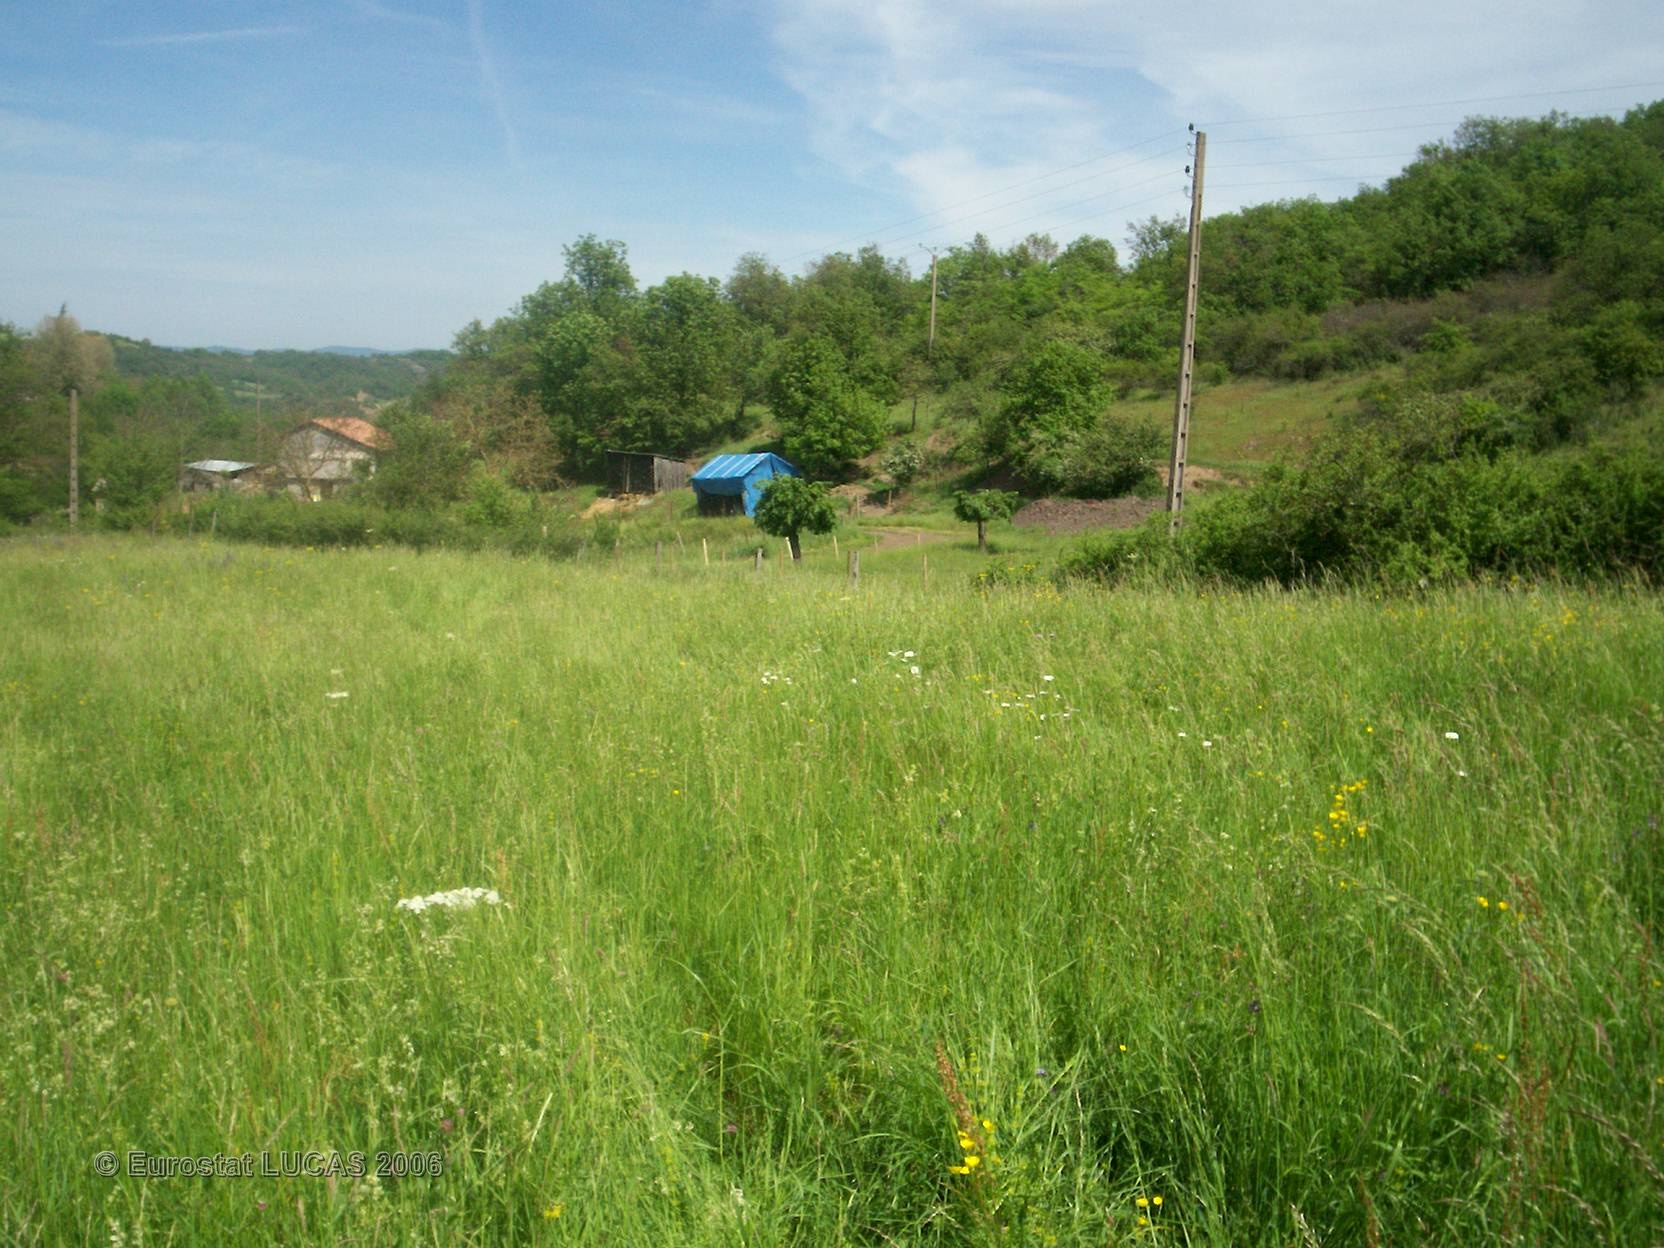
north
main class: Grassland
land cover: Grassland without tree/shrub cover
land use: Agriculture (excluding fallow land and kitchen gardens)
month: May
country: FR
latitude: 45.4371
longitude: 3.3158
